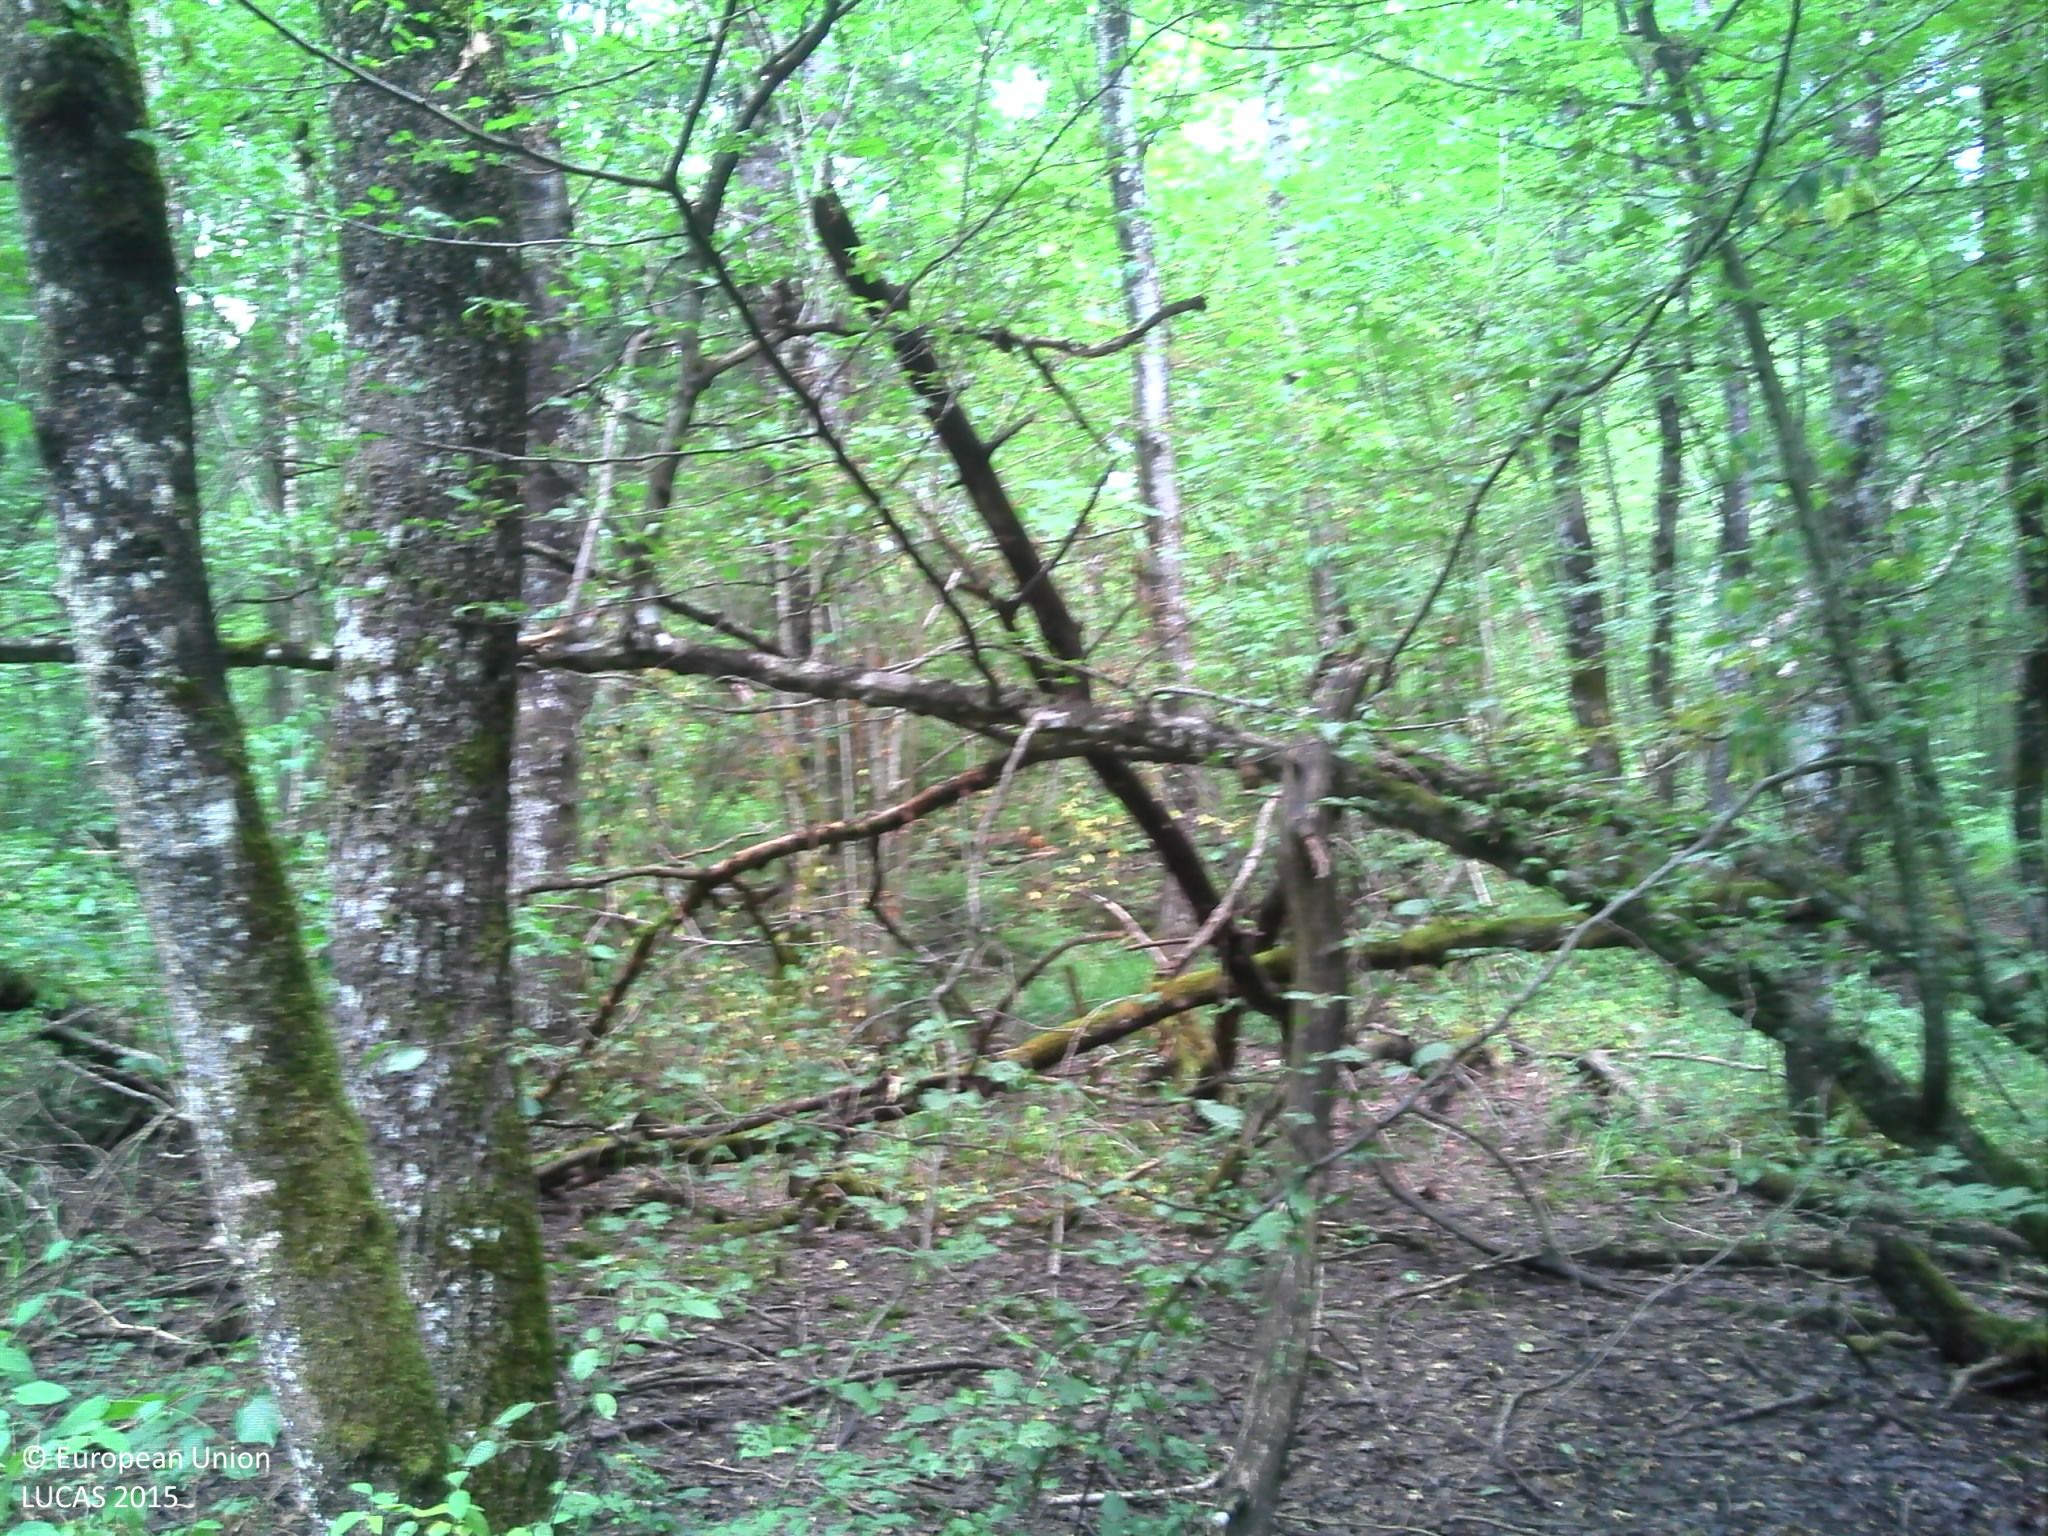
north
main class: Woodland
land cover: Broadleaved woodland
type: beech forest
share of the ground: > 75 %
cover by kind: broadleaved forest trees 70 %, herbaceous plants 25 %, lichens and mosses 5 %
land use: Forestry
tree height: > 5 m
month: July
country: FR
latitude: 46.3413
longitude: 6.3004
